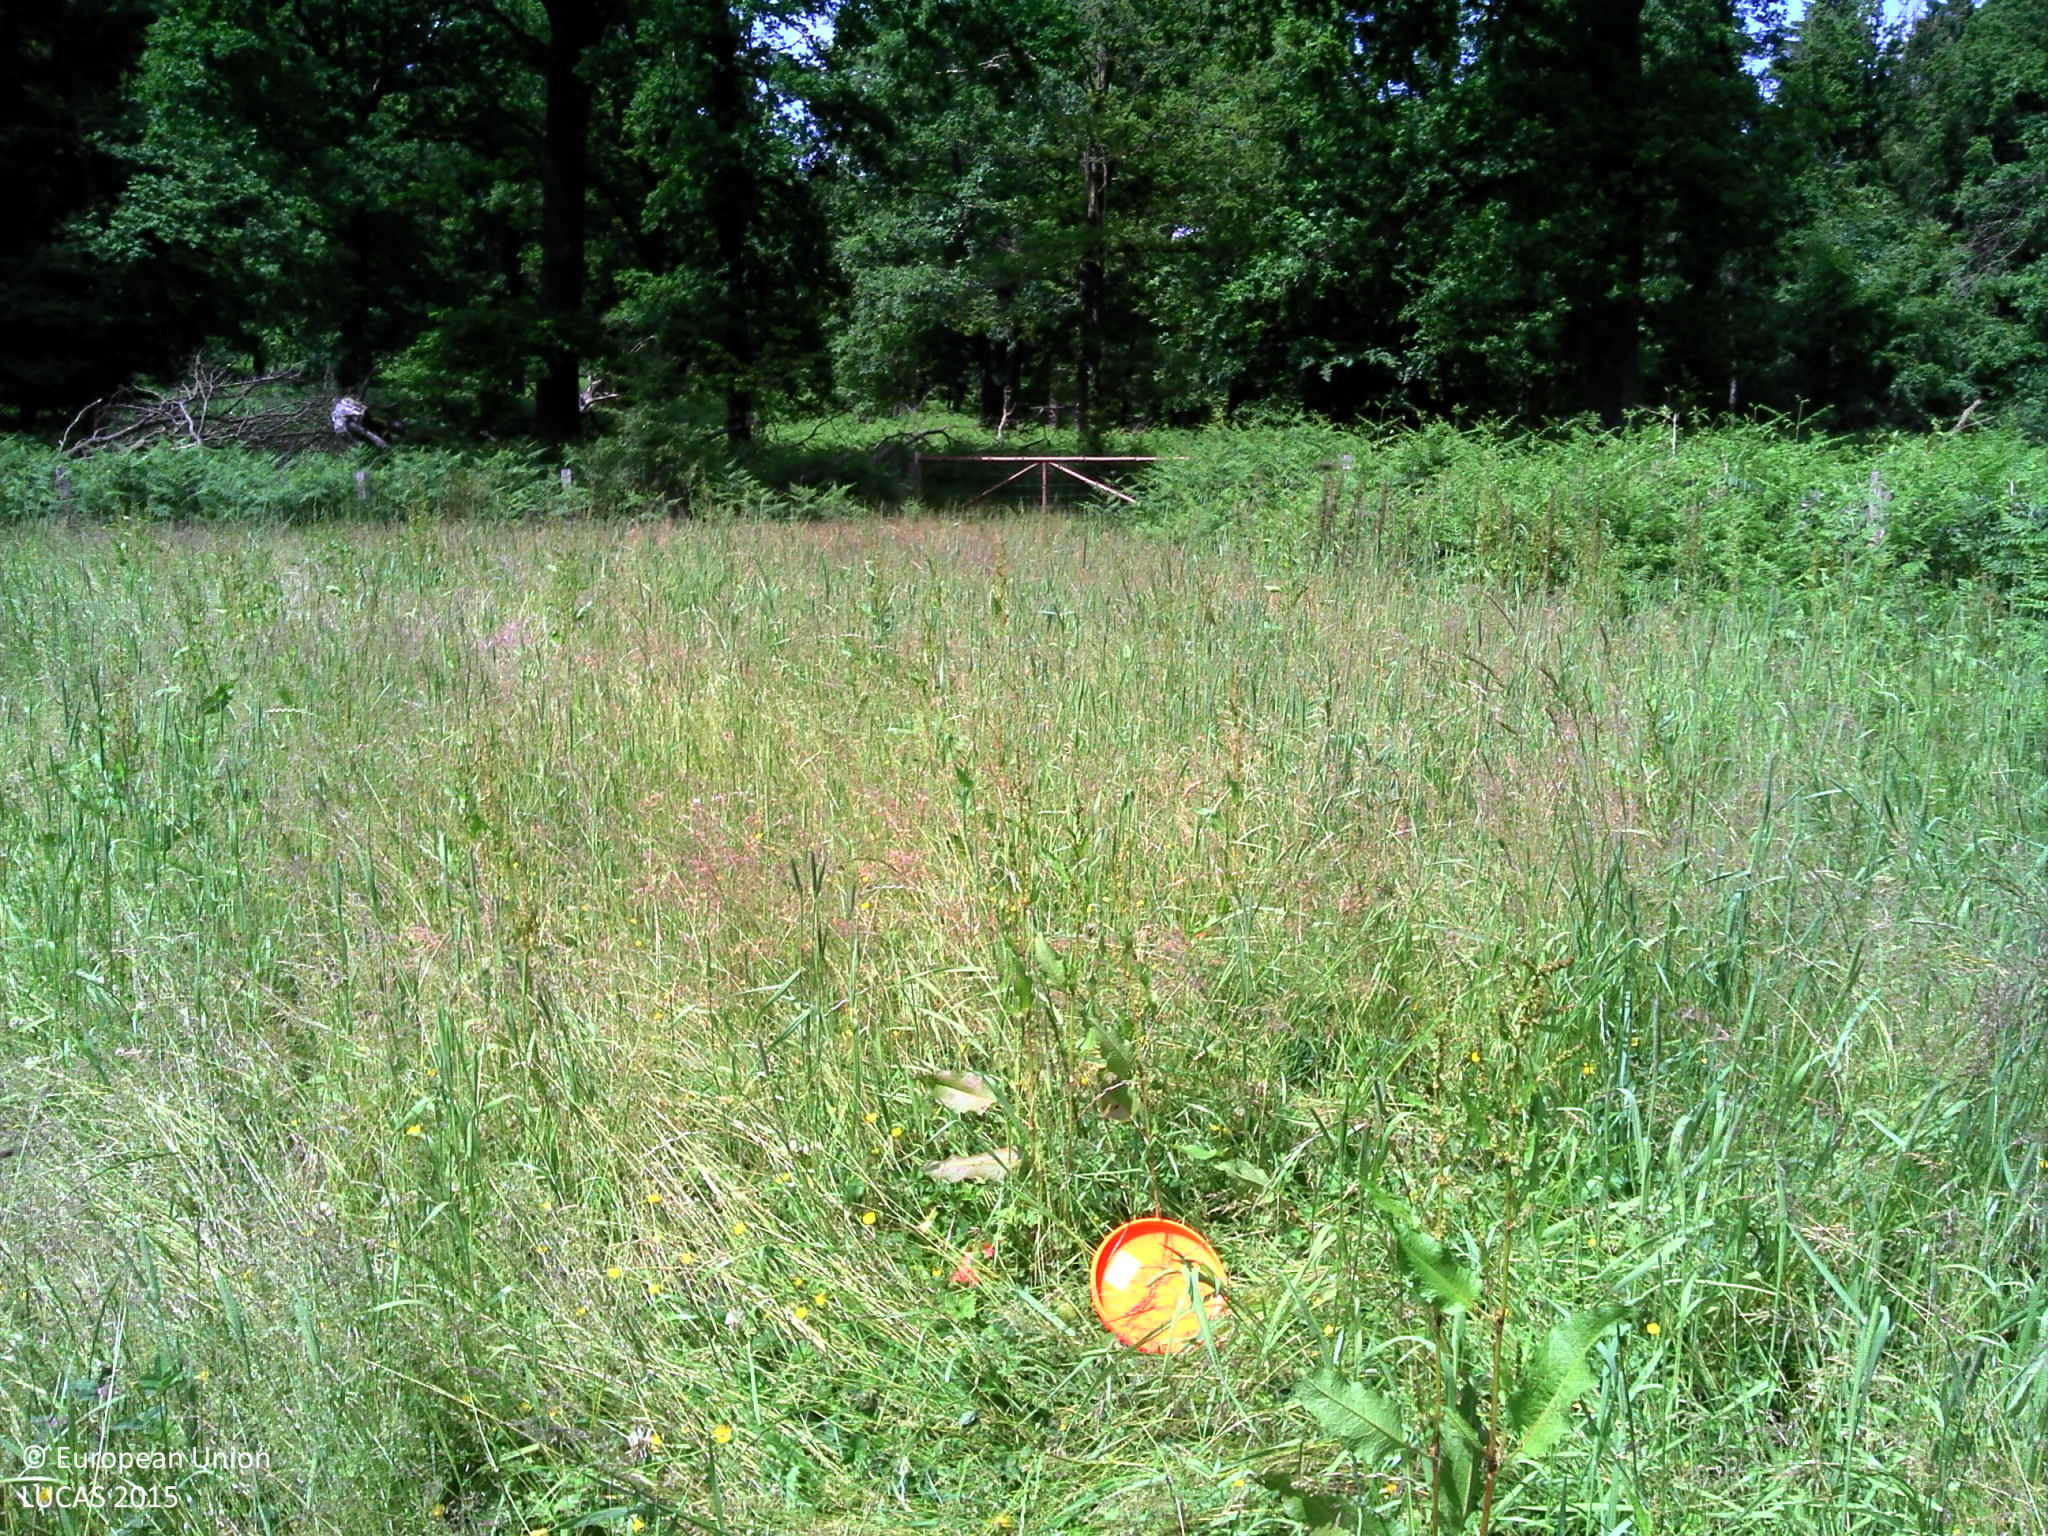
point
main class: Woodland
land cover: Broadleaved woodland
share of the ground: > 75 %
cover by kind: broadleaved forest trees 90 %, herbaceous plants 10 %
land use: Forestry
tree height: > 5 m
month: June
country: BE
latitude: 50.0104
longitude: 5.1835
